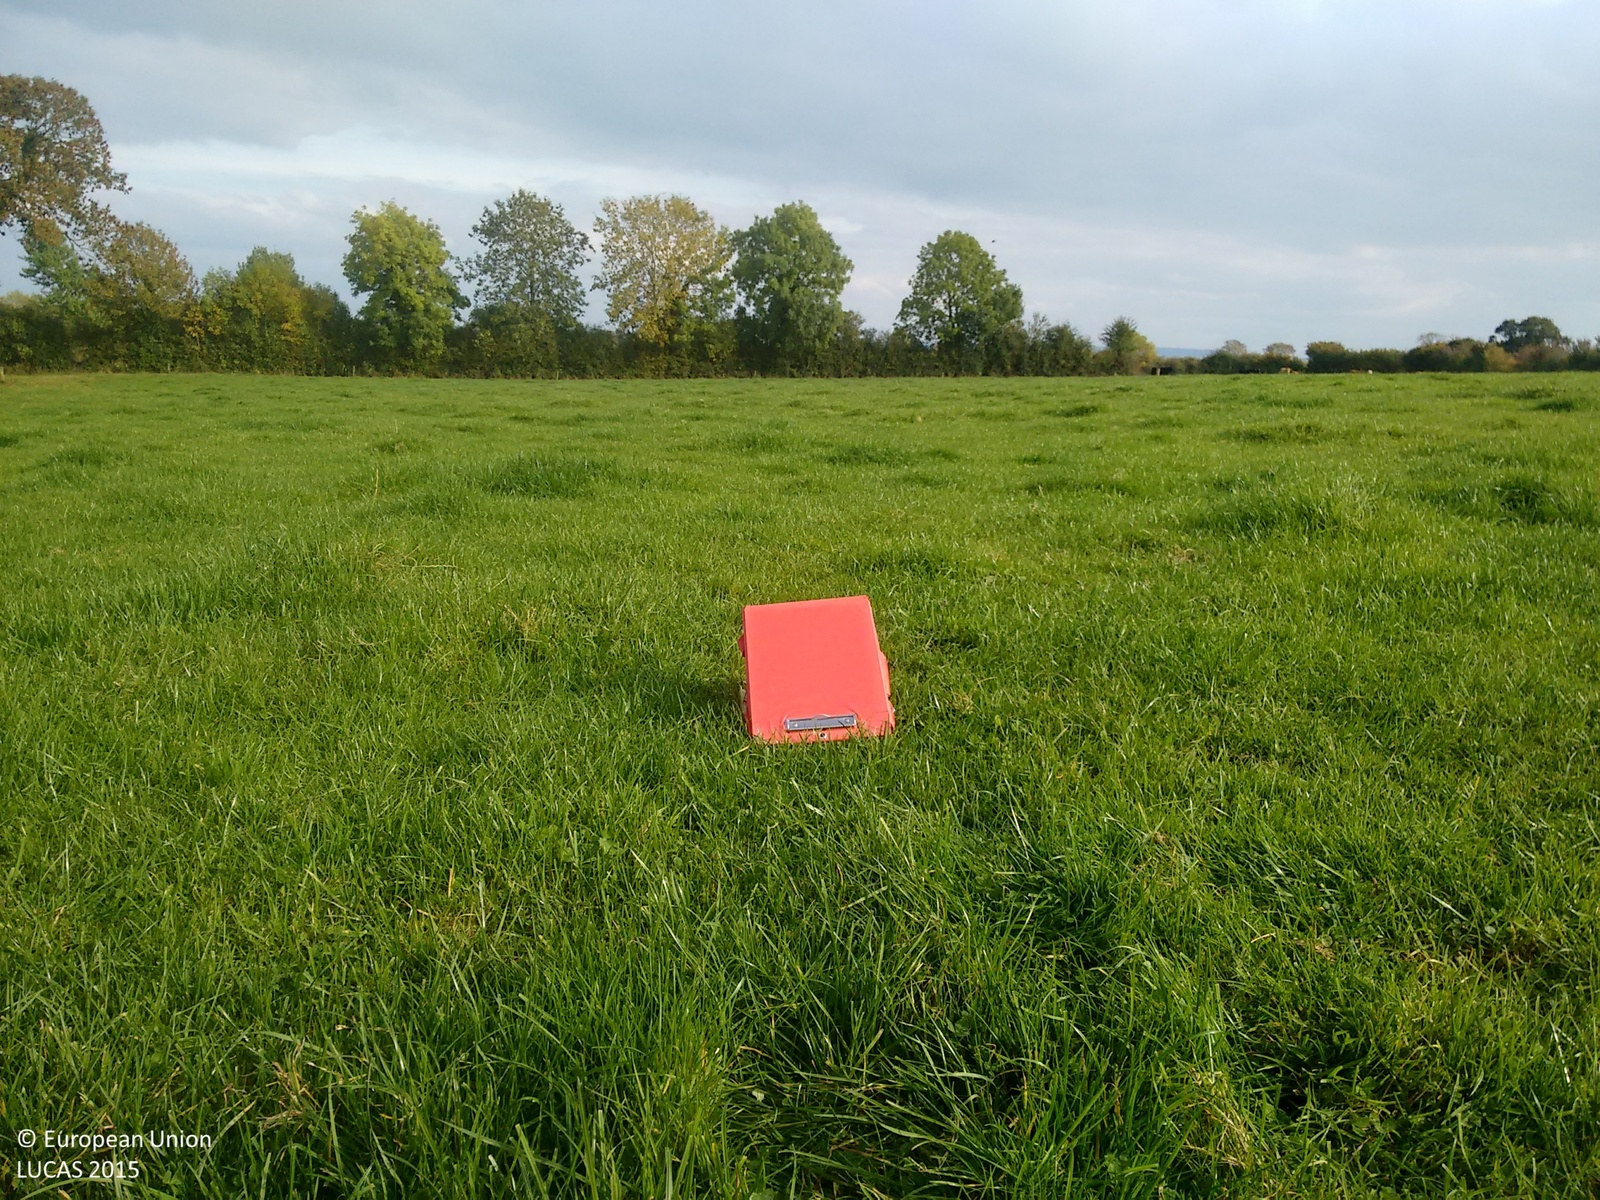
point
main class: Grassland
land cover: Grassland without tree/shrub cover
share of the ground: > 75 %
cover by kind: herbaceous plants 100 %
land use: Agriculture (excluding fallow land and kitchen gardens)
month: October
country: IE
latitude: 52.8690
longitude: -7.6180
